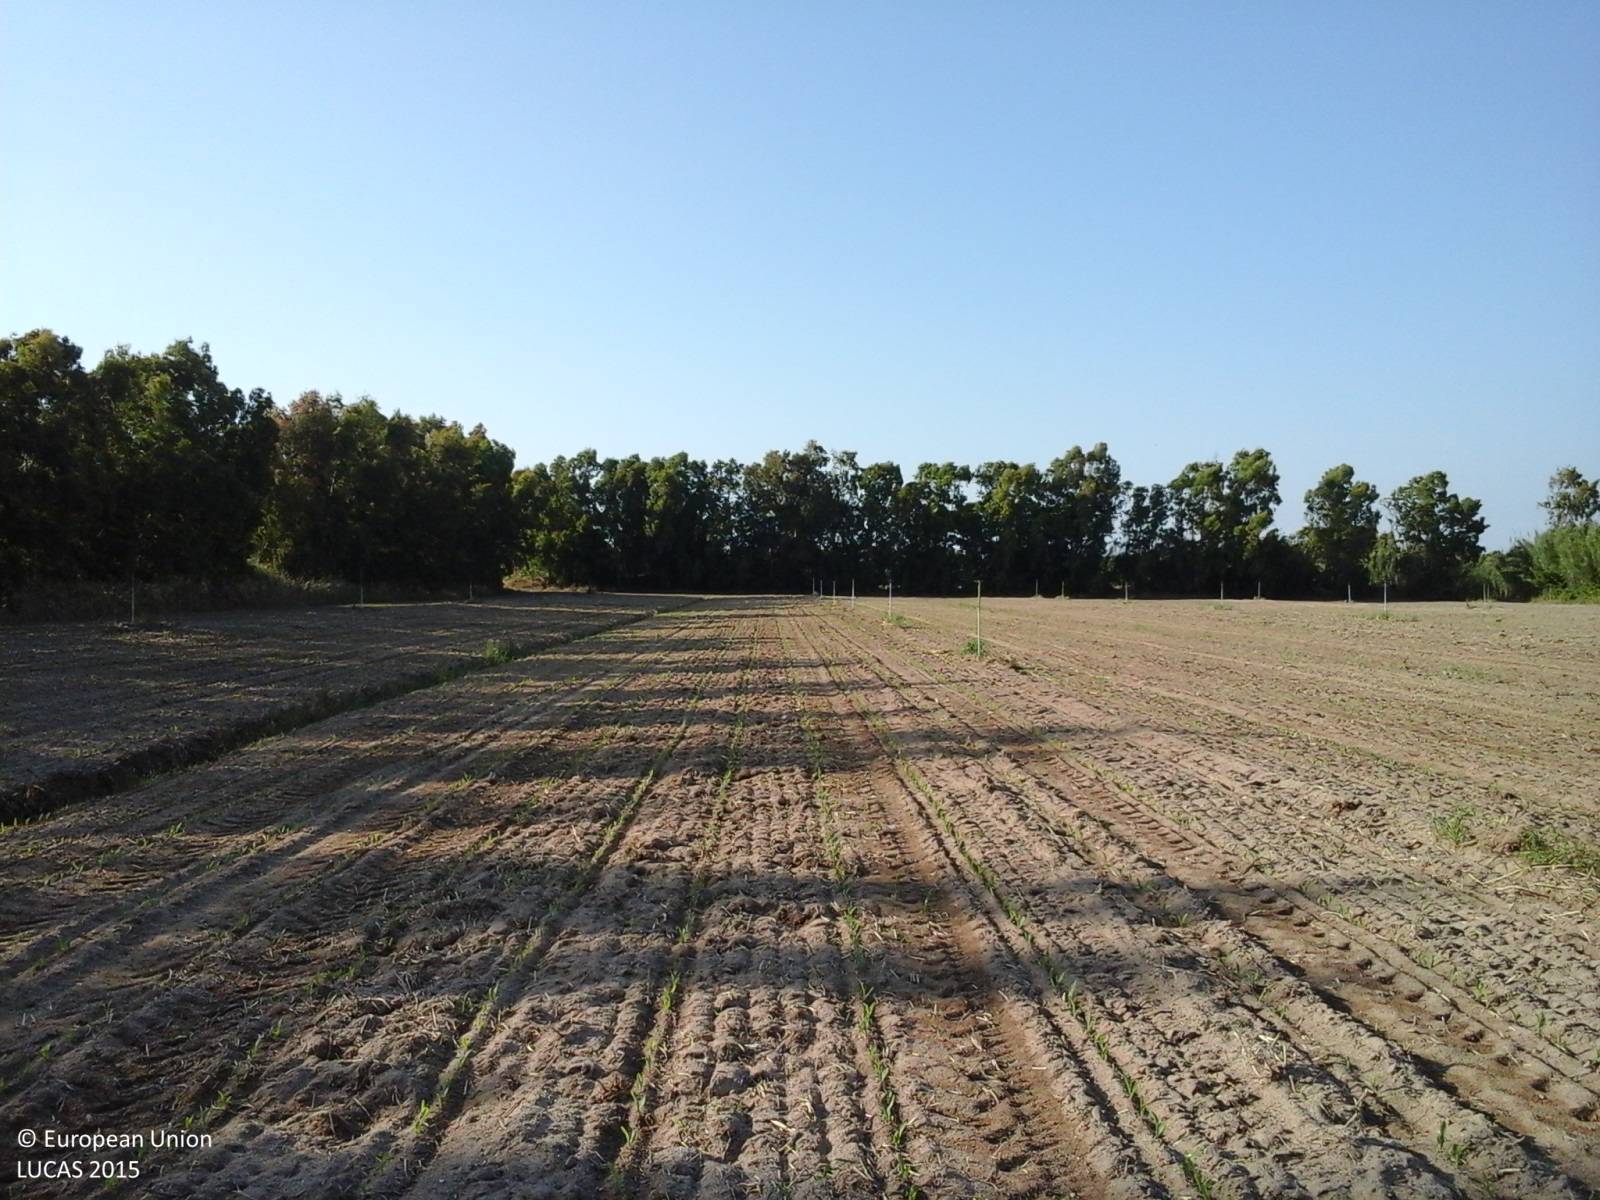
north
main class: Cropland
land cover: Maize
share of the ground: < 10 %
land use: Agriculture (excluding fallow land and kitchen gardens)
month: May
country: IT
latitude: 39.8042
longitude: 8.5714
